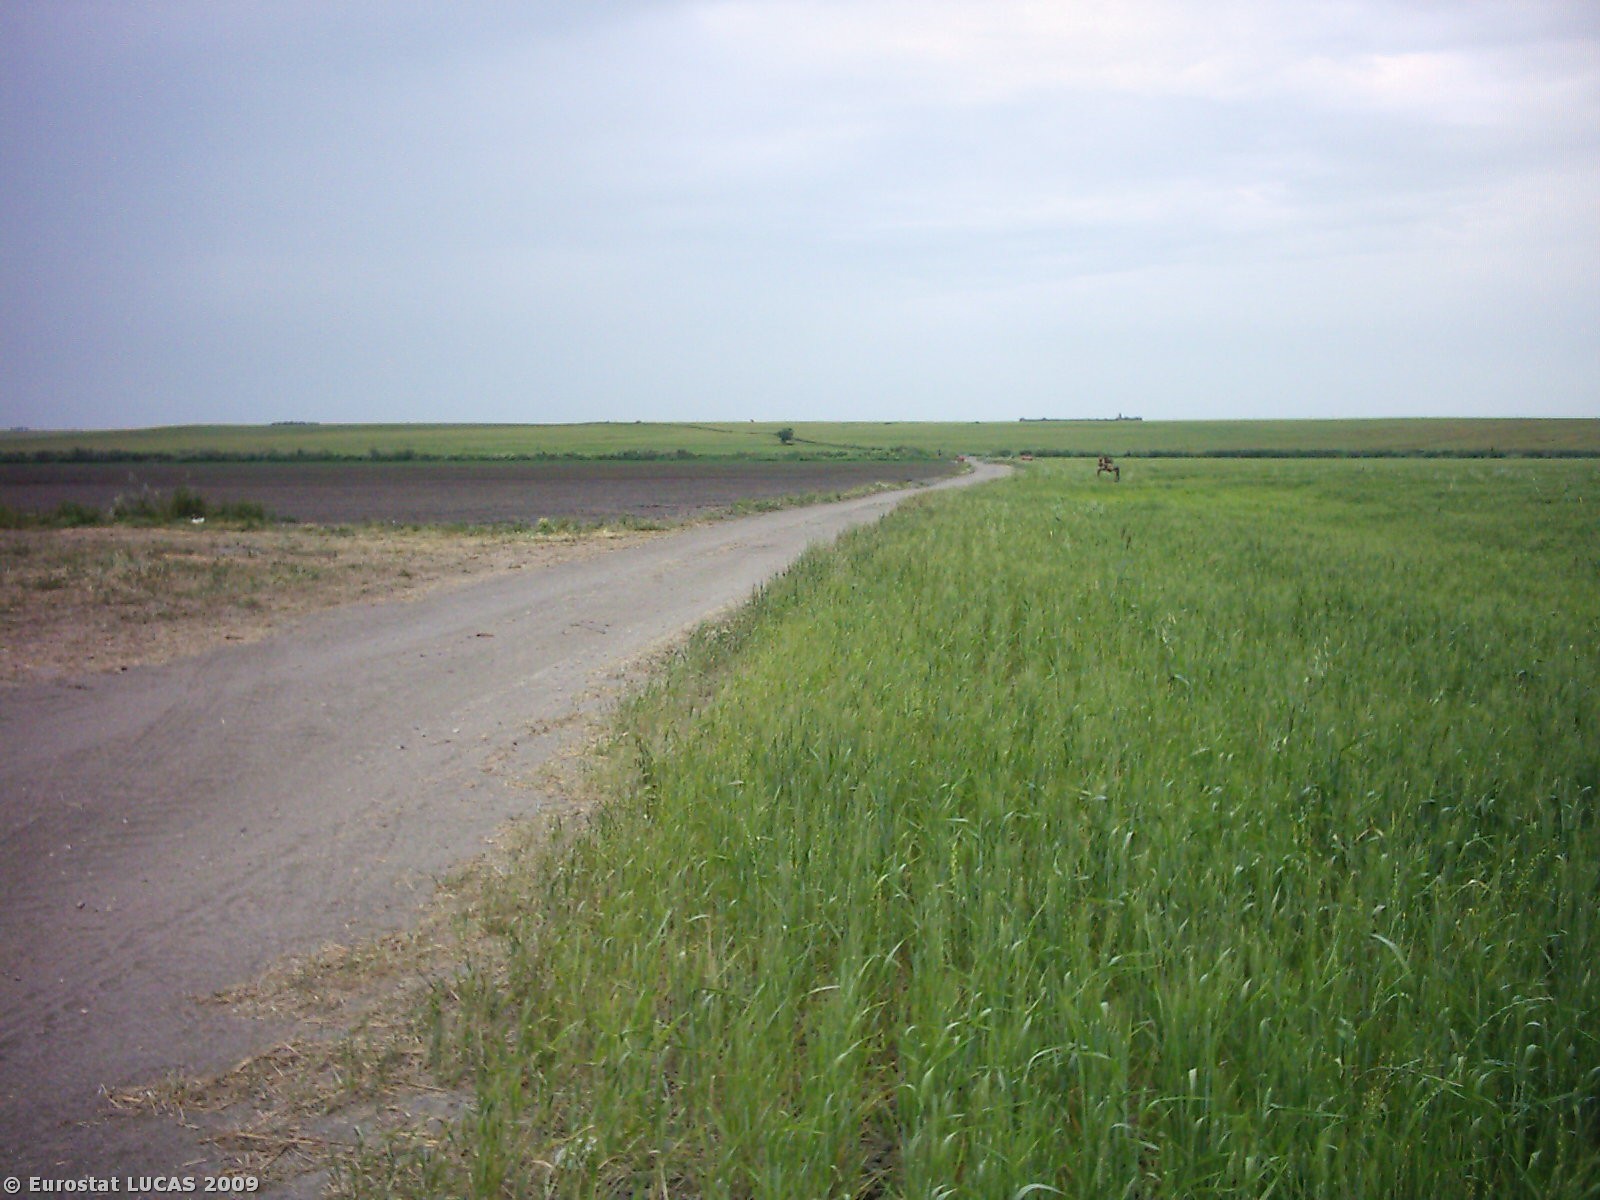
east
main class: Cropland
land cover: Durum wheat
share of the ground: > 75 %
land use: Agriculture (excluding fallow land and kitchen gardens)
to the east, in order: Durum wheat
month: May
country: IT
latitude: 41.5185
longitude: 15.6499
